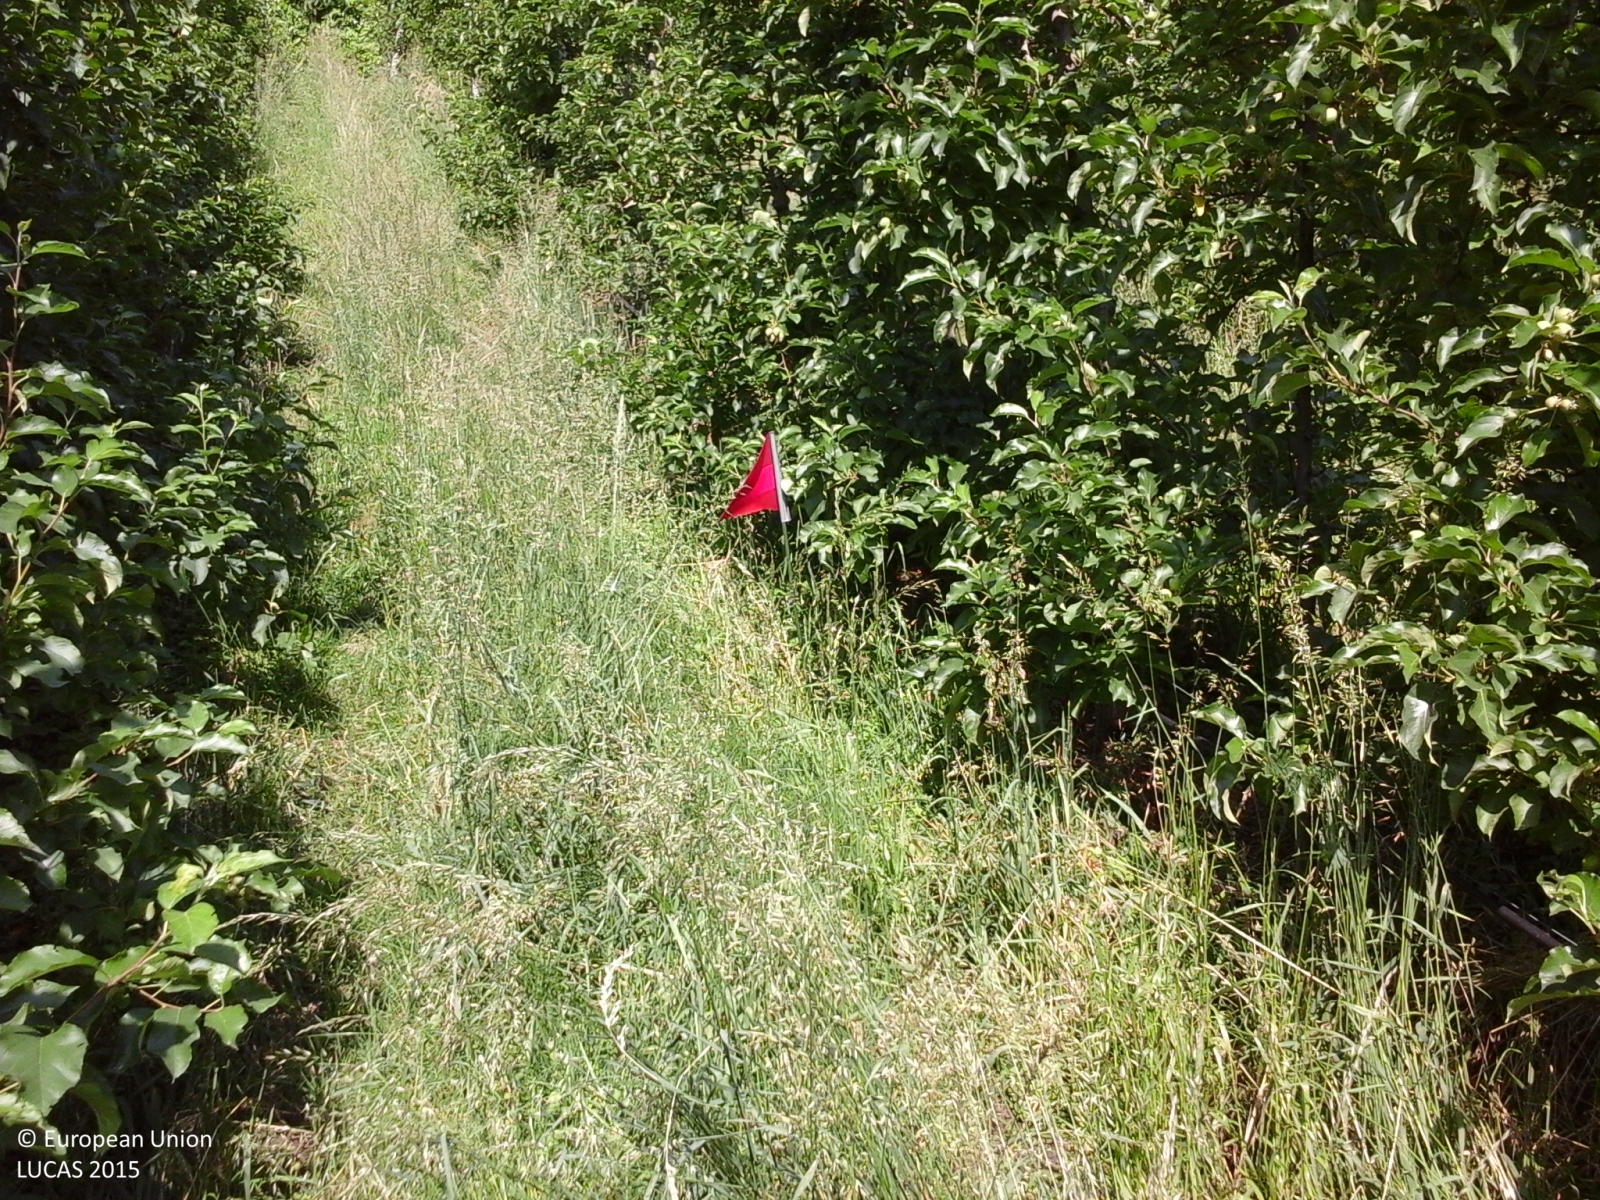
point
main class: Cropland
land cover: Apple fruit
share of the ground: > 75 %
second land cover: Grassland without tree/shrub cover
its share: > 75 %
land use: Agriculture (excluding fallow land and kitchen gardens)
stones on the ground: < 10 %
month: May
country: IT
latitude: 46.6154
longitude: 11.1347
